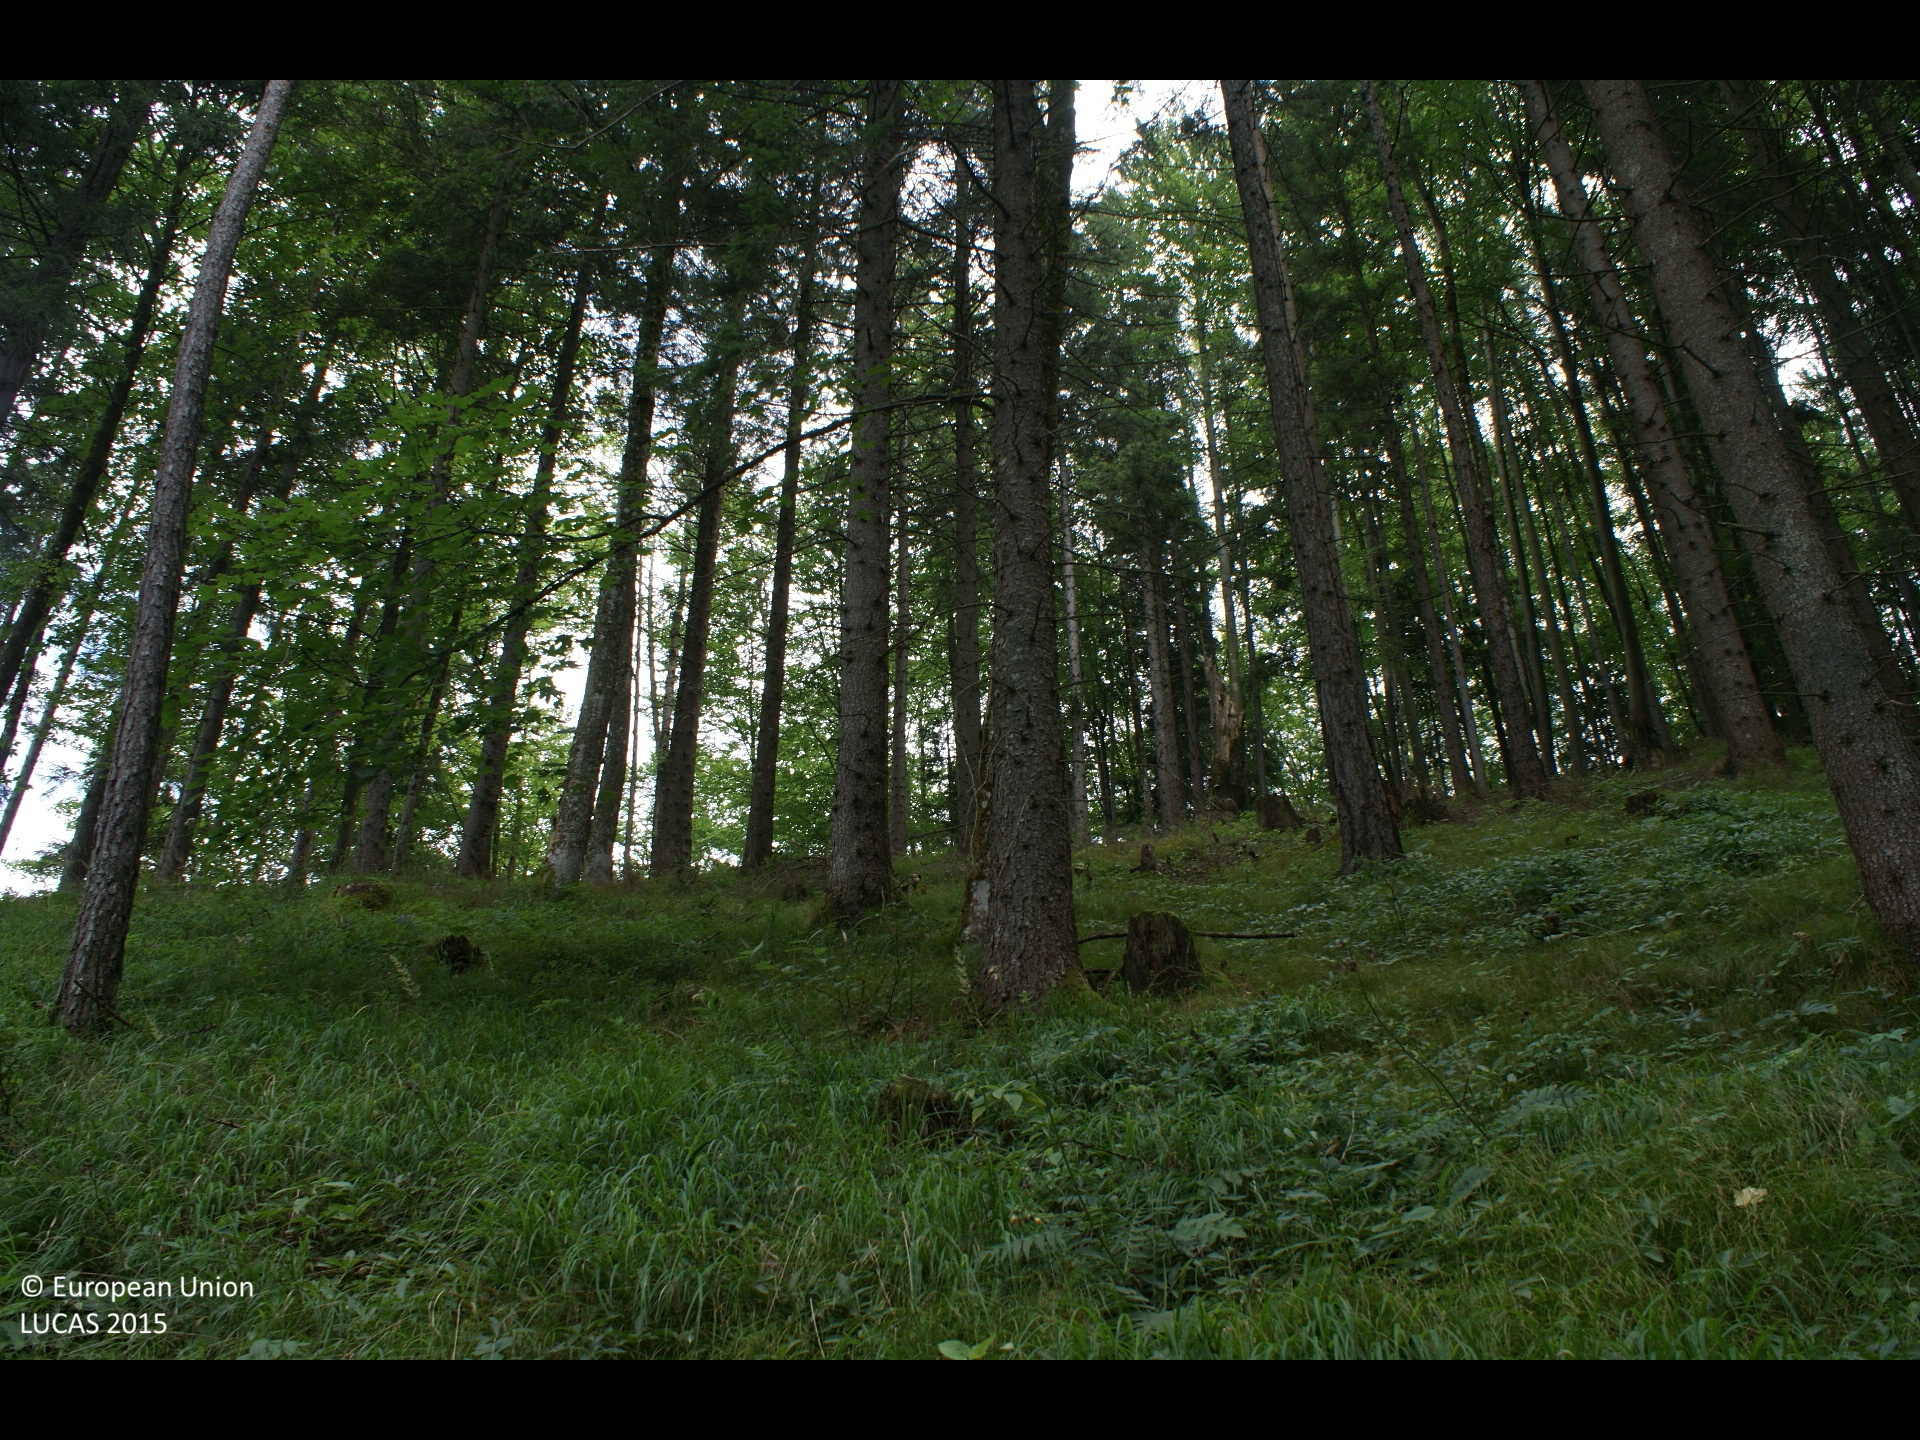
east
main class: Woodland
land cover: Spruce dominated mixed woodland
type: mesophytic deciduous forest
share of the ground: > 75 %
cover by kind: broadleaved forest trees 55 %, coniferous forest trees 25 %, herbaceous plants 15 %, lichens and mosses 5 %
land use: Forestry
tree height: > 5 m
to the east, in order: Spruce dominated mixed woodland; Broadleaved woodland; Tracks; Spruce dominated mixed woodland; Shruby margins; Tracks; Broadleaved woodland; Spruce dominated mixed woodland
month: July
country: AT
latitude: 47.8428
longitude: 14.9311
